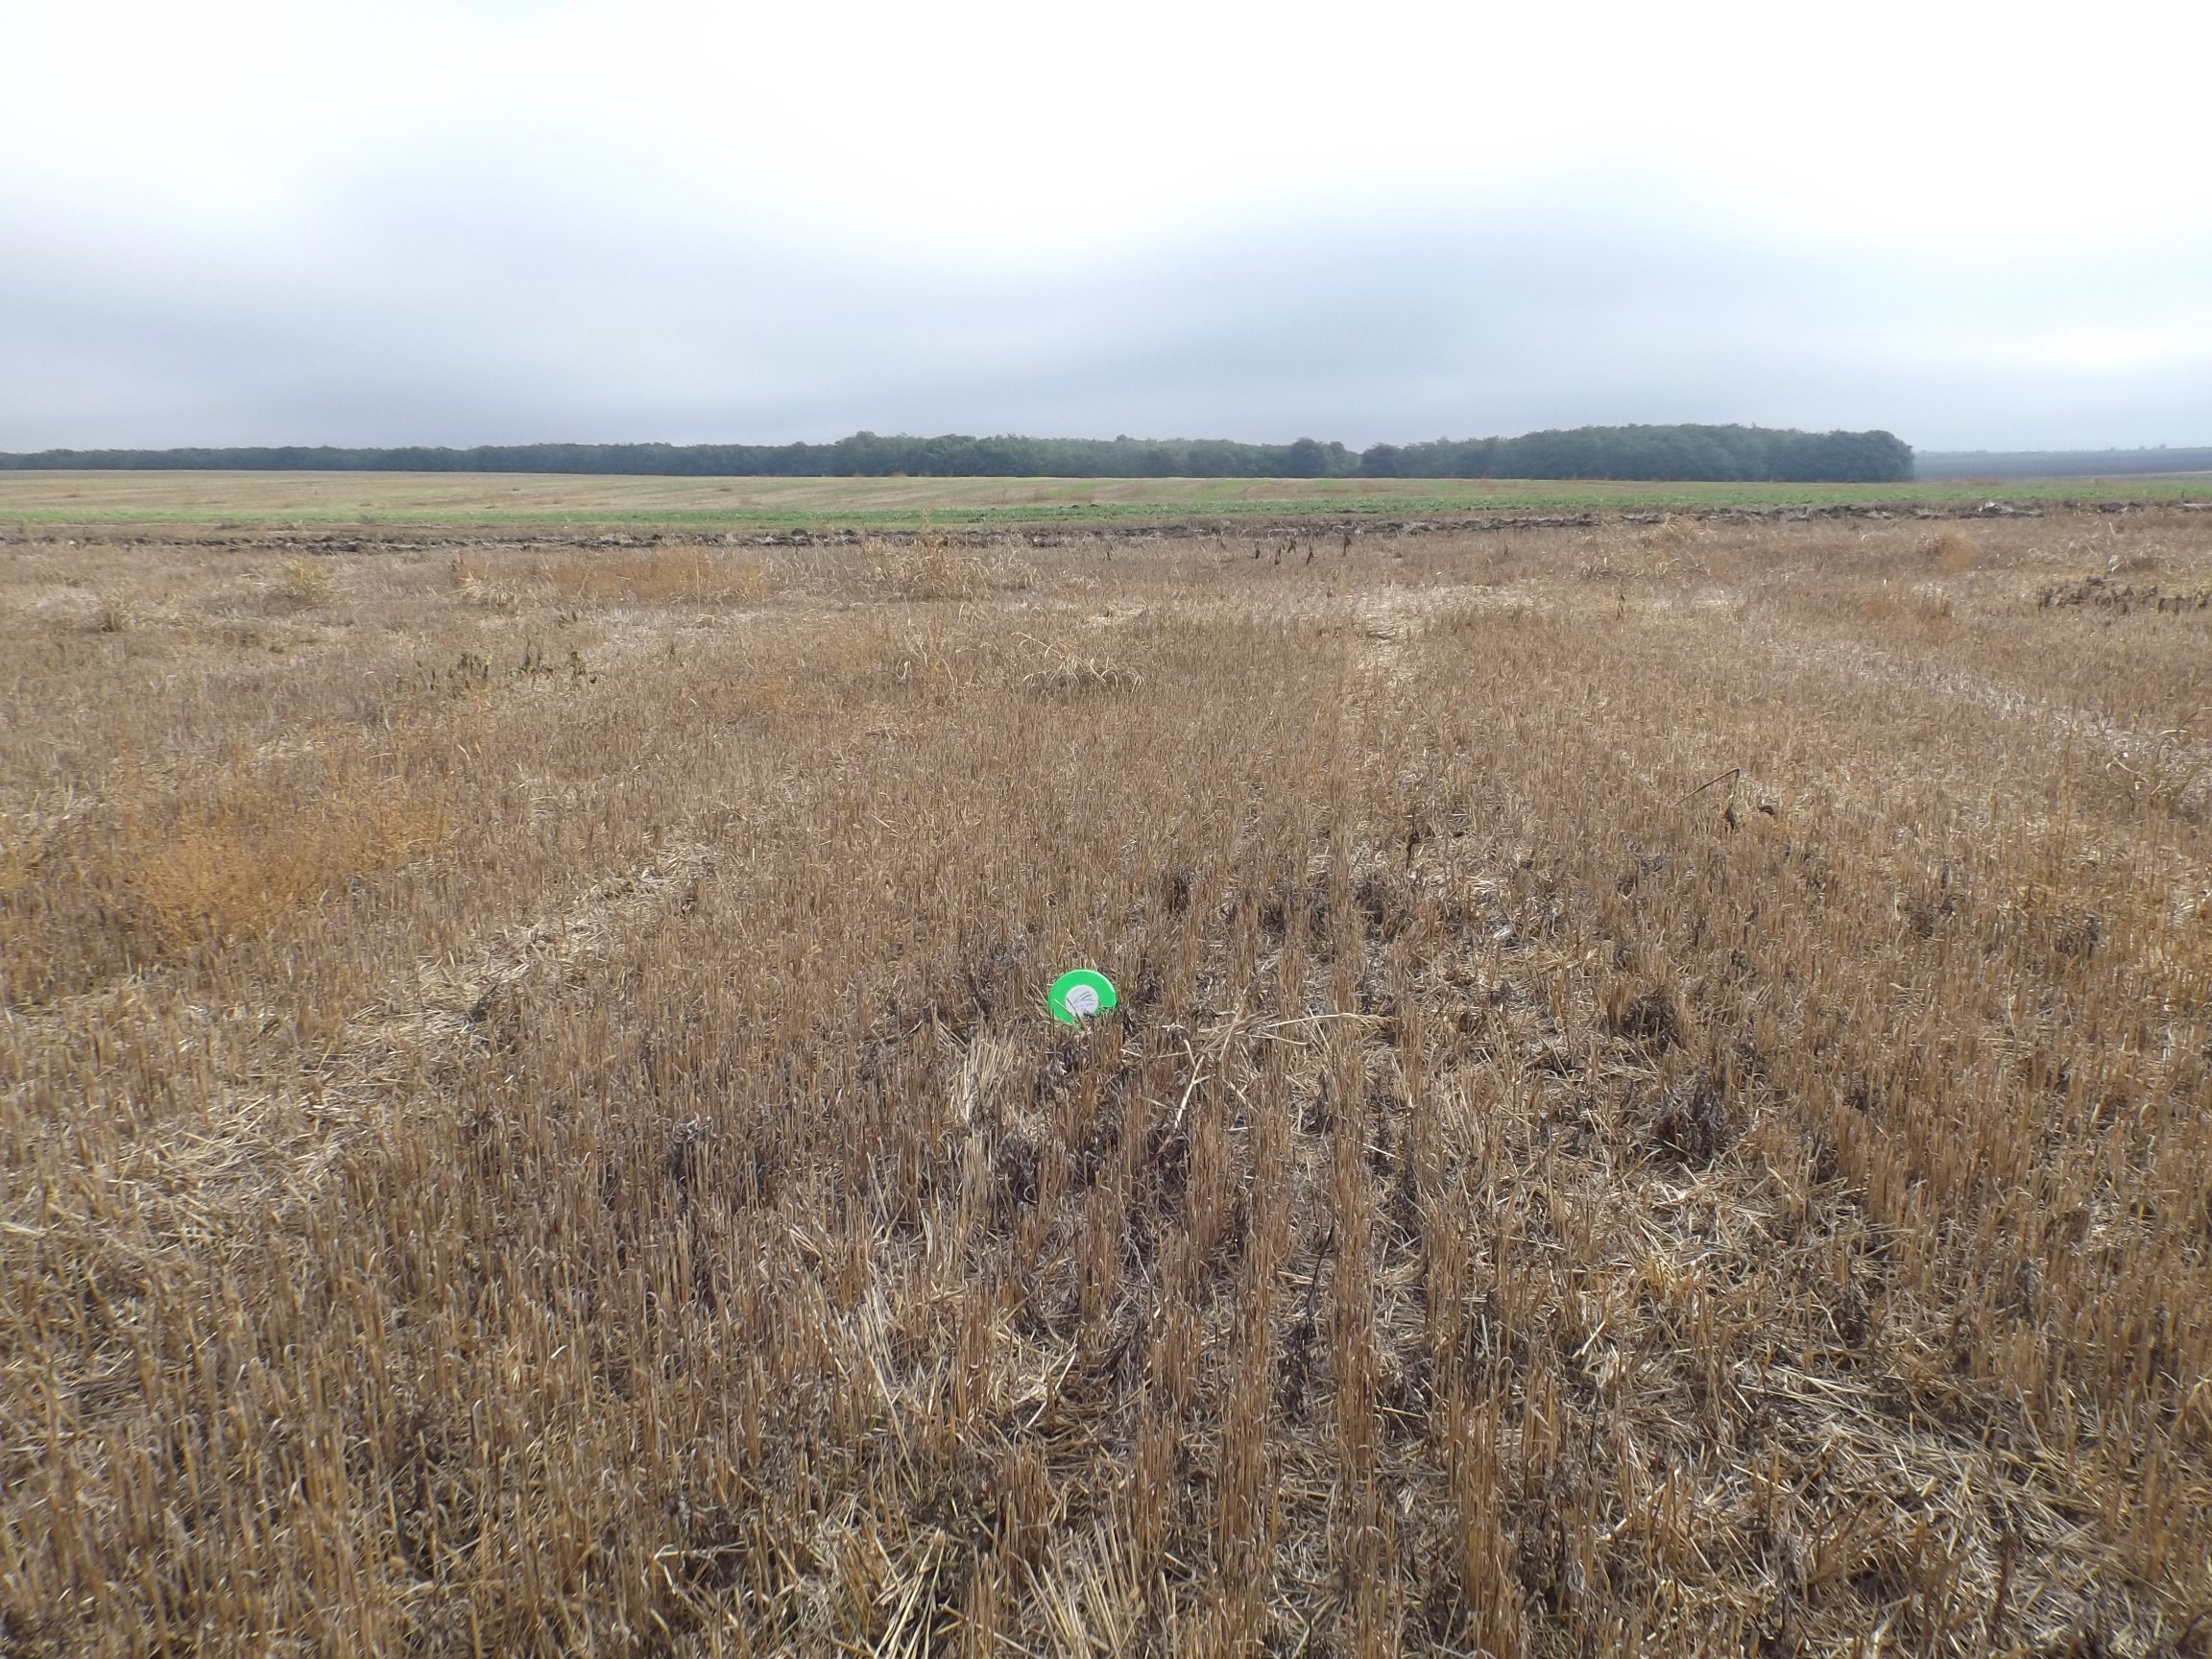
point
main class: Cropland
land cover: Oats
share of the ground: 50 - 75 %
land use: Agriculture (excluding fallow land and kitchen gardens)
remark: Harvested field
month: September
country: BG
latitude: 43.9762
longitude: 26.3749
